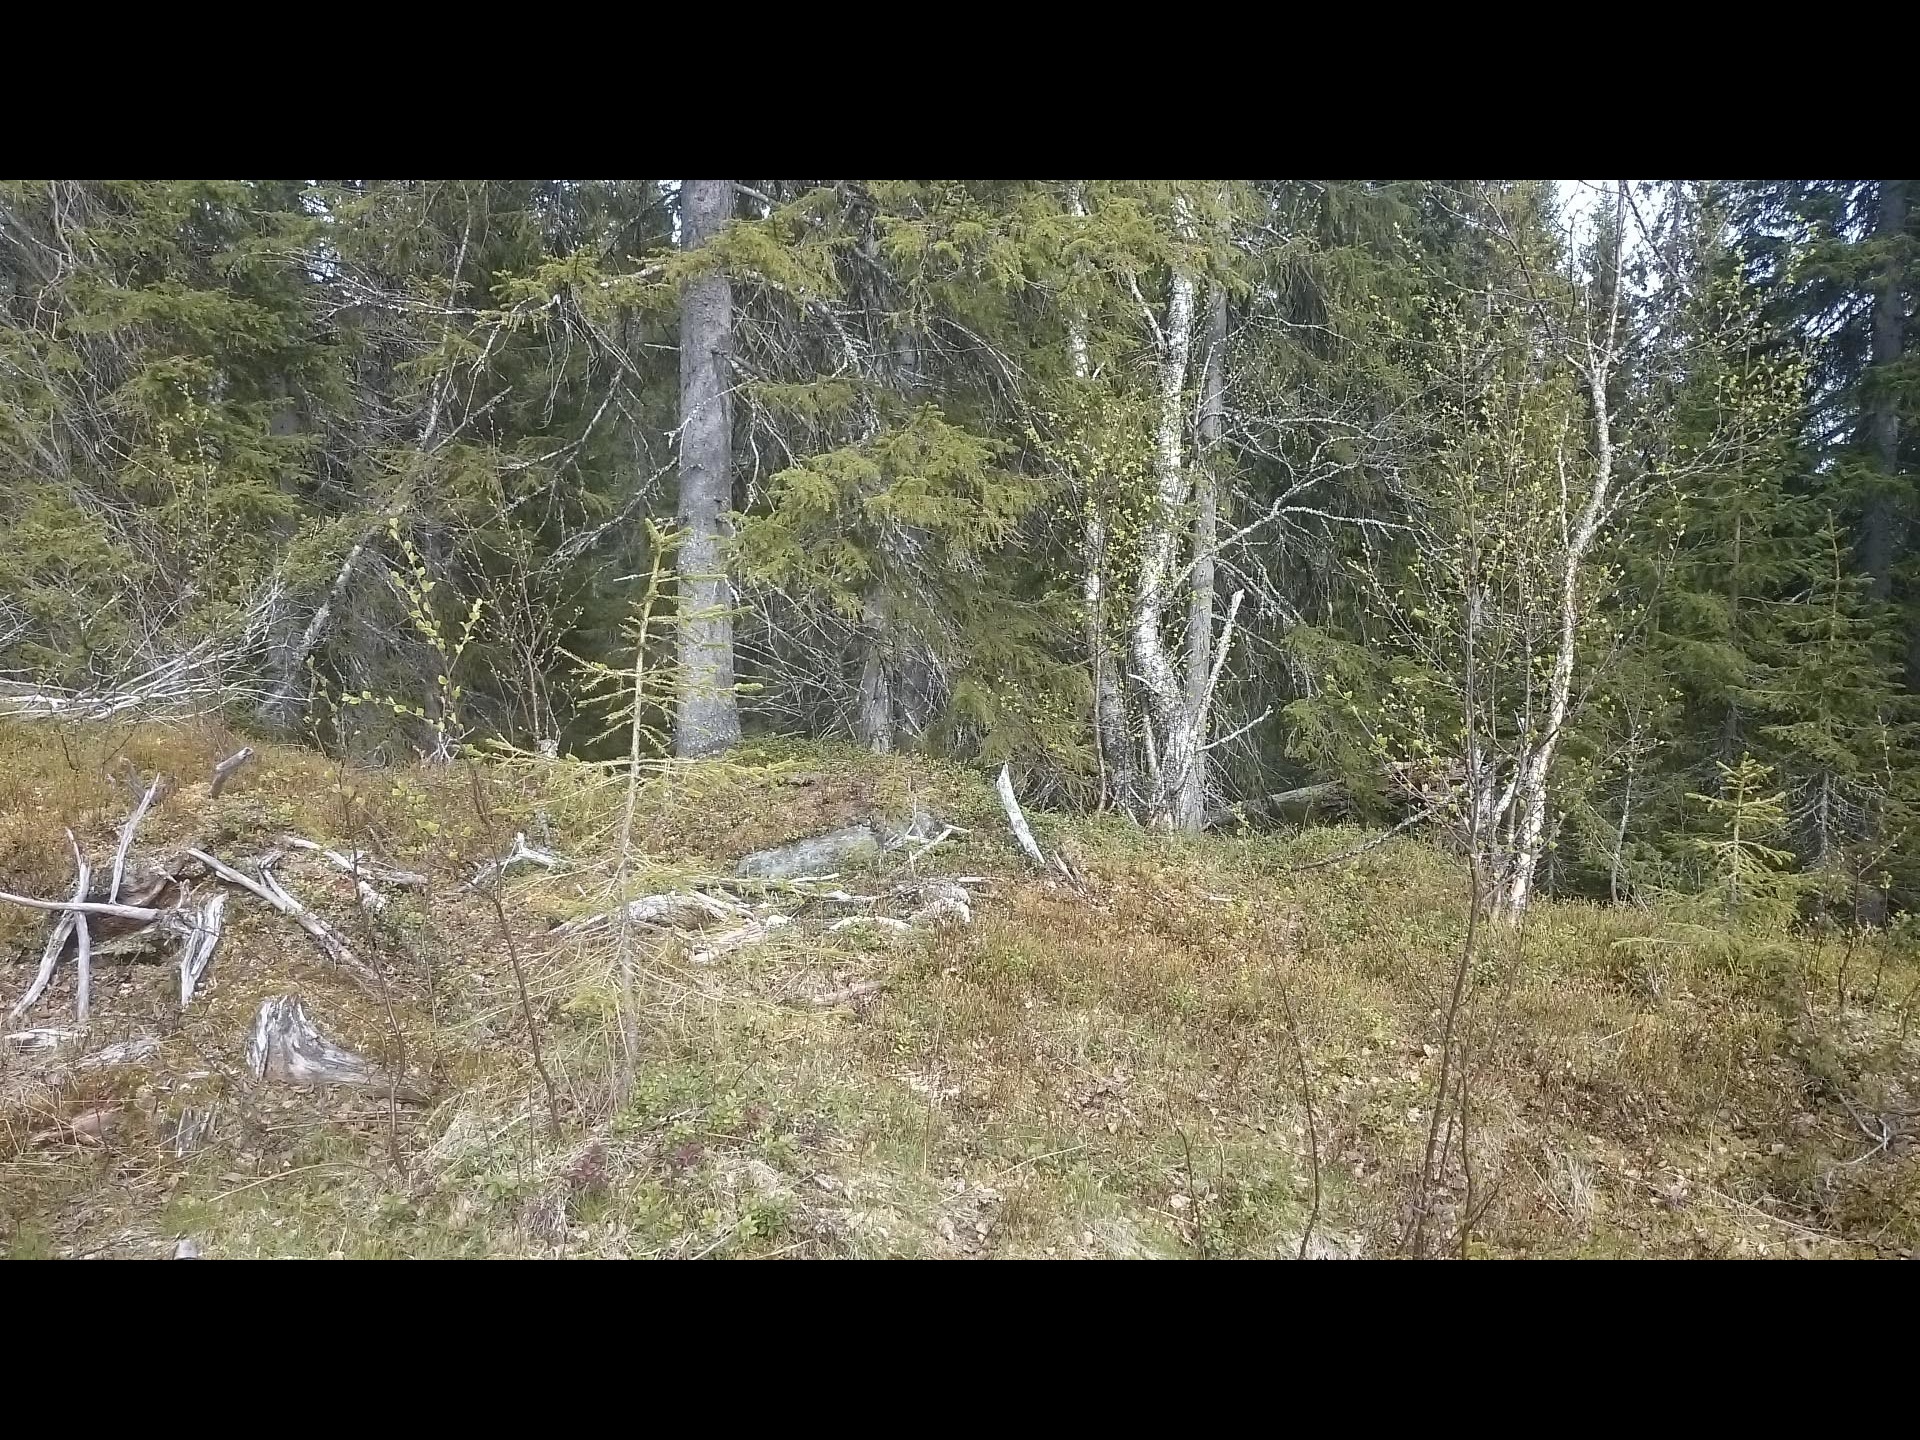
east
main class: Woodland
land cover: Spruce dominated mixed woodland
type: boreal forest
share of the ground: 25 - 50 %
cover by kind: herbaceous plants 35 %, coniferous forest trees 30 %, shrubs 25 %, broadleaved forest trees 10 %
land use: Forestry
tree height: < 5 m
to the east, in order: Spruce dominated mixed woodland; Spruce dominated coniferous woodland; Rivers and streams; Spruce dominated coniferous woodland; Spruce dominated mixed woodland
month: June
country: SE
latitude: 63.7189
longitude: 13.8459
